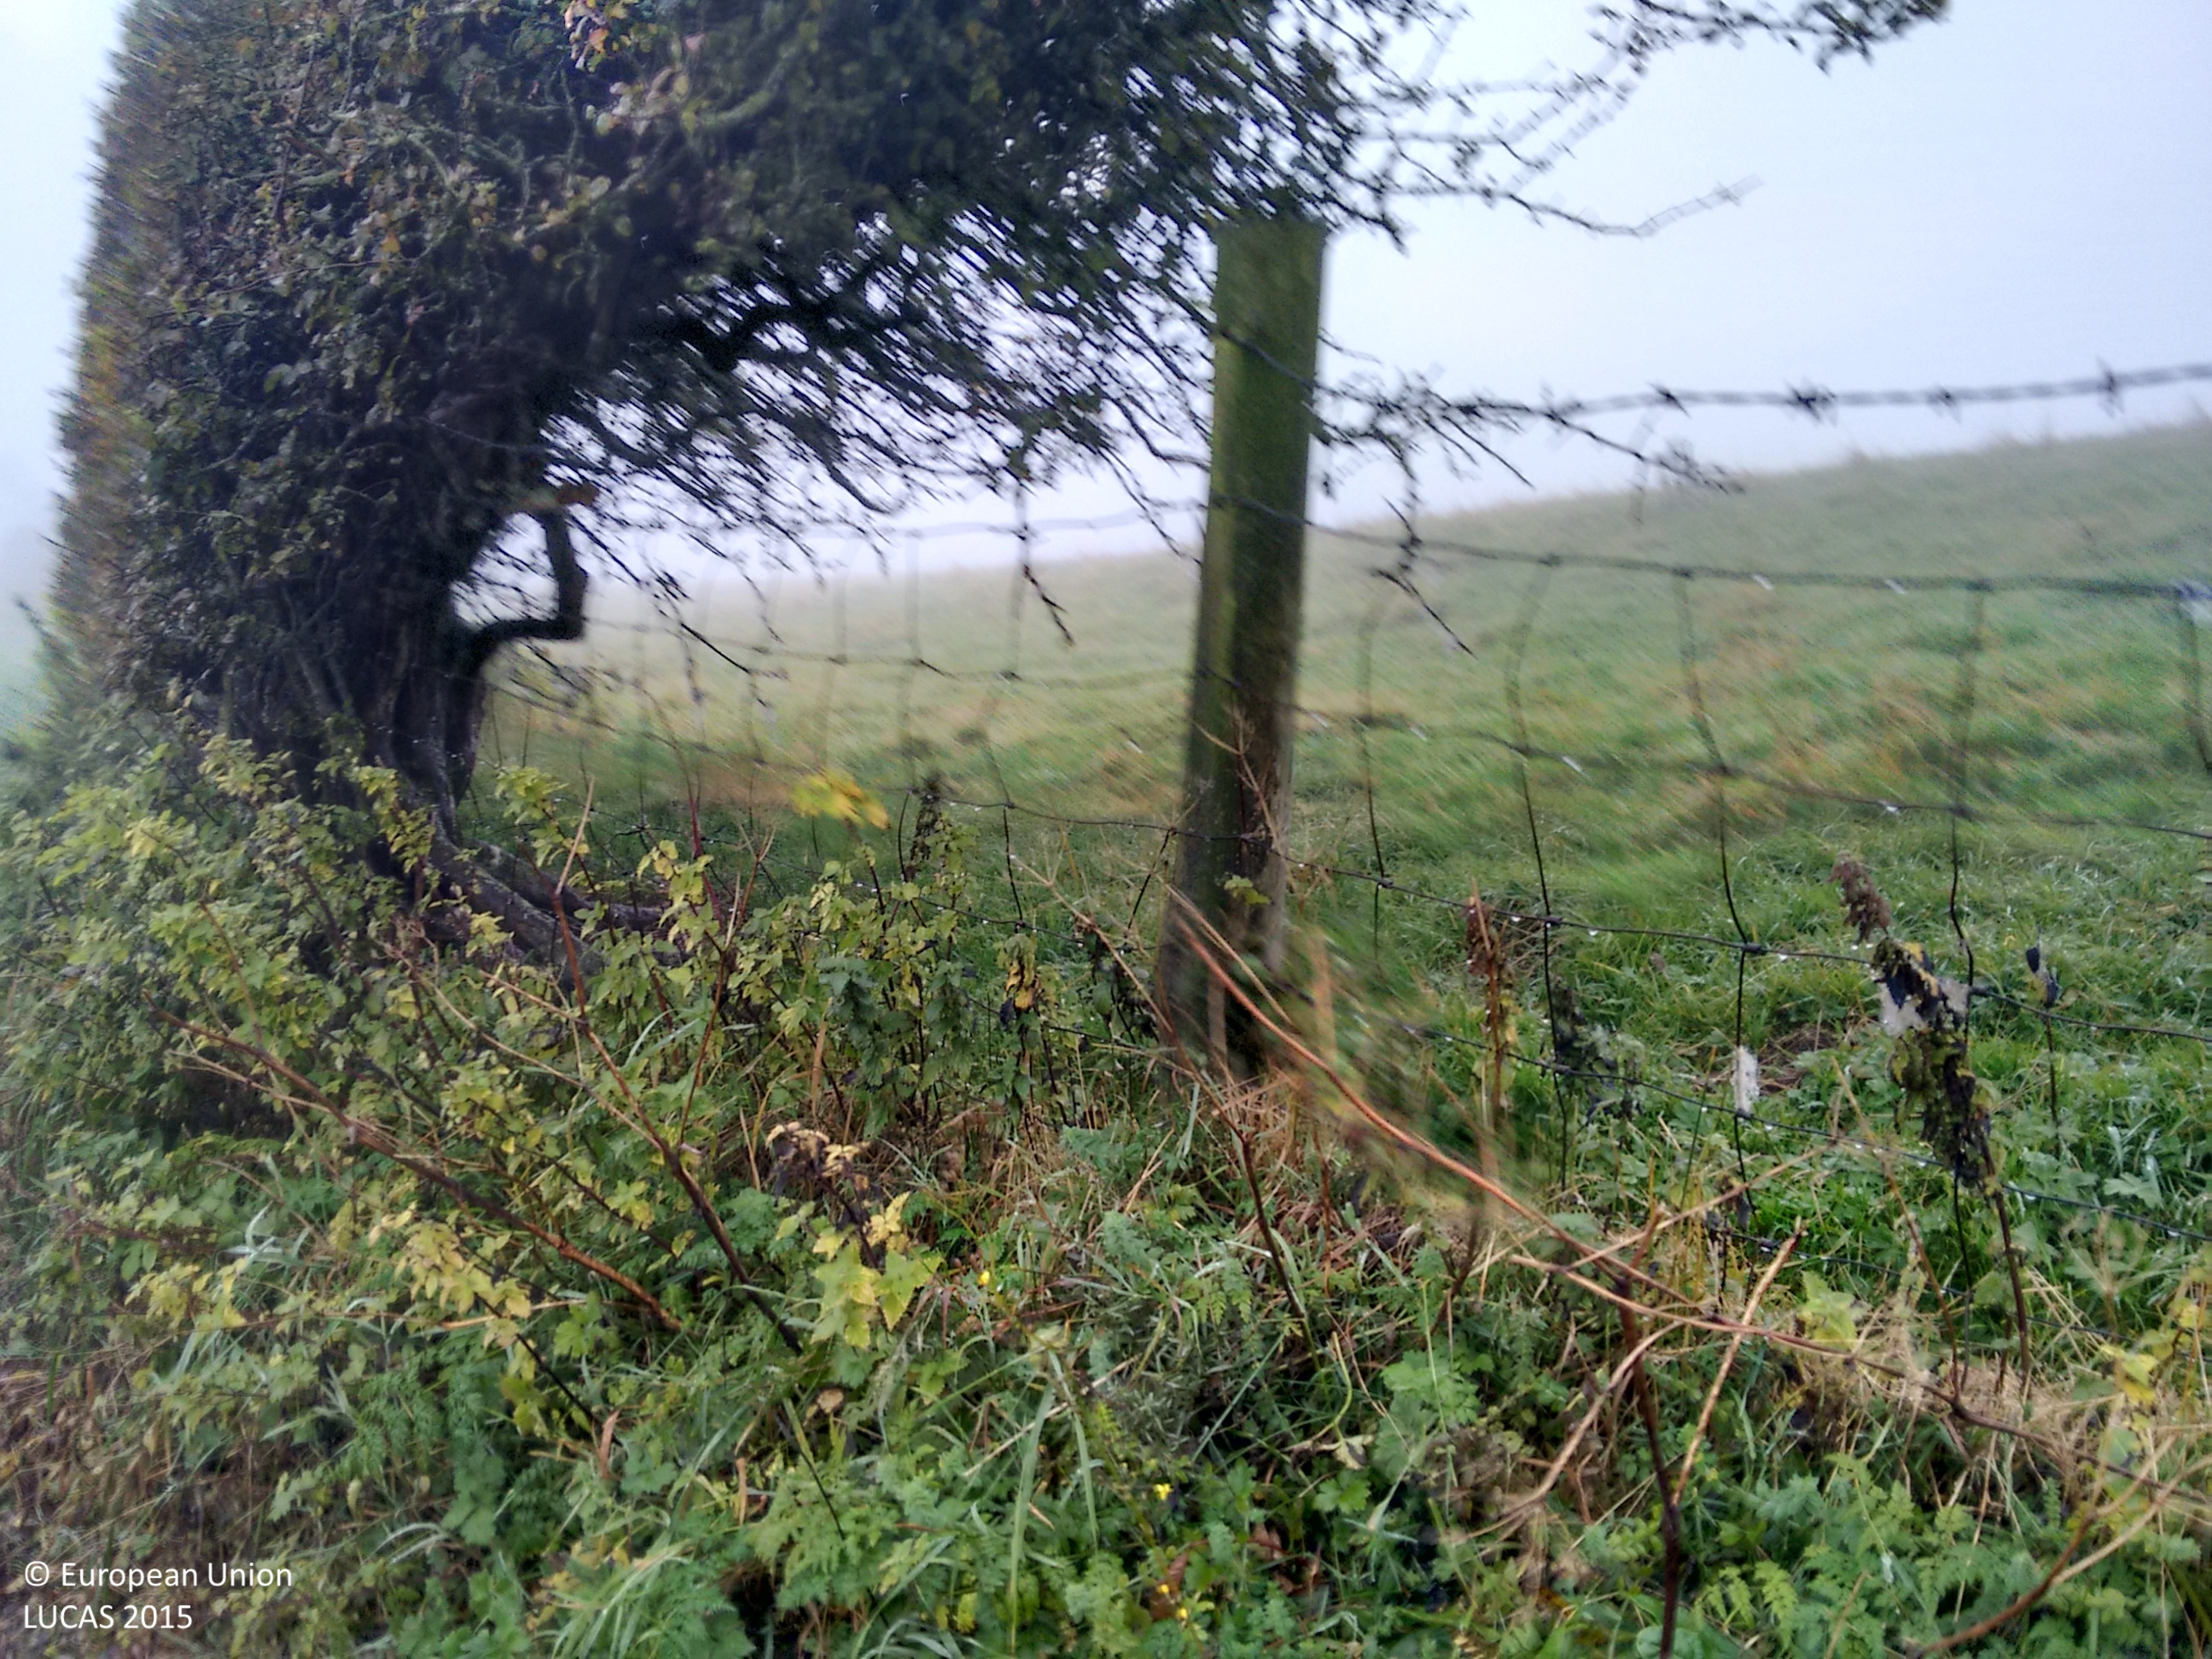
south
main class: Grassland
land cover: Grassland without tree/shrub cover
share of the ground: > 75 %
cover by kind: herbaceous plants 100 %
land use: Agriculture (excluding fallow land and kitchen gardens)
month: October
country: GB
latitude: 54.4803
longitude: -1.9547
